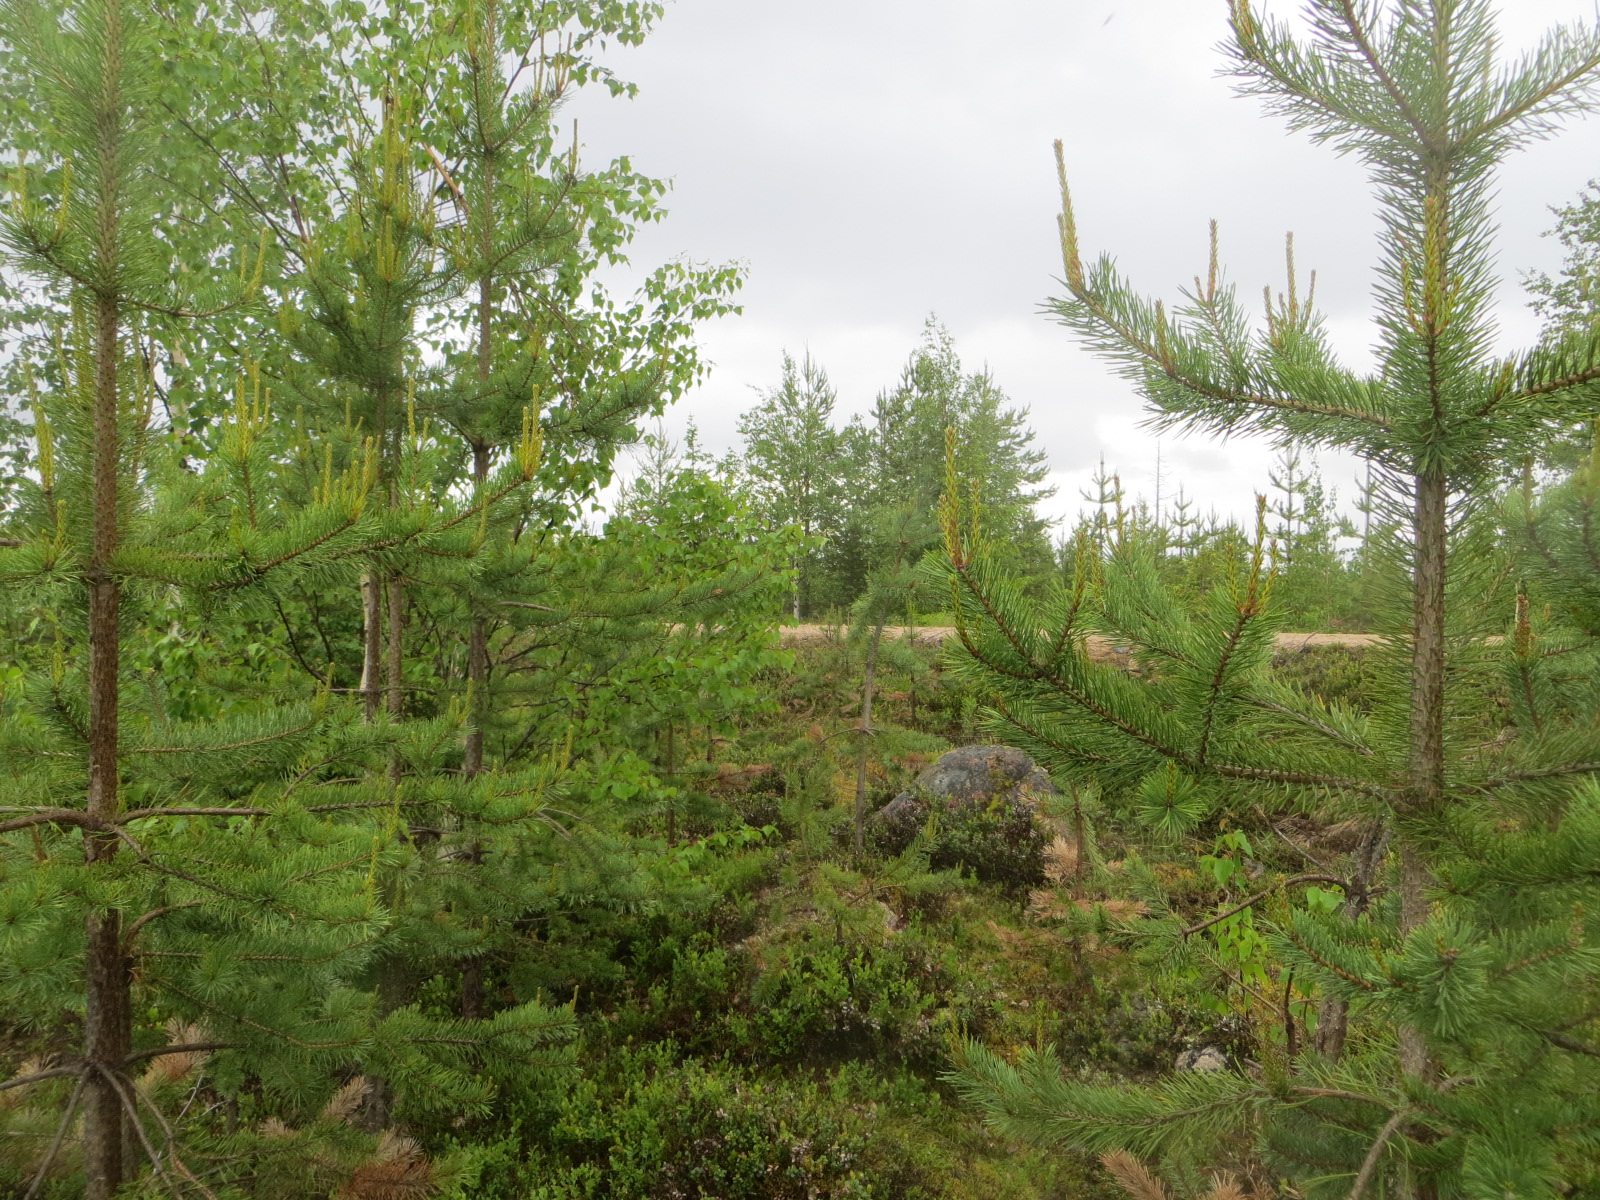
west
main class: Woodland
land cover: Pine dominated mixed woodland
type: boreal forest
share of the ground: 50 - 75 %
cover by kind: coniferous forest trees 45 %, broadleaved forest trees 25 %, shrubs 20 %, lichens and mosses 10 %
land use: Forestry
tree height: < 5 m
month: June
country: FI
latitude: 66.0249
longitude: 26.9332
